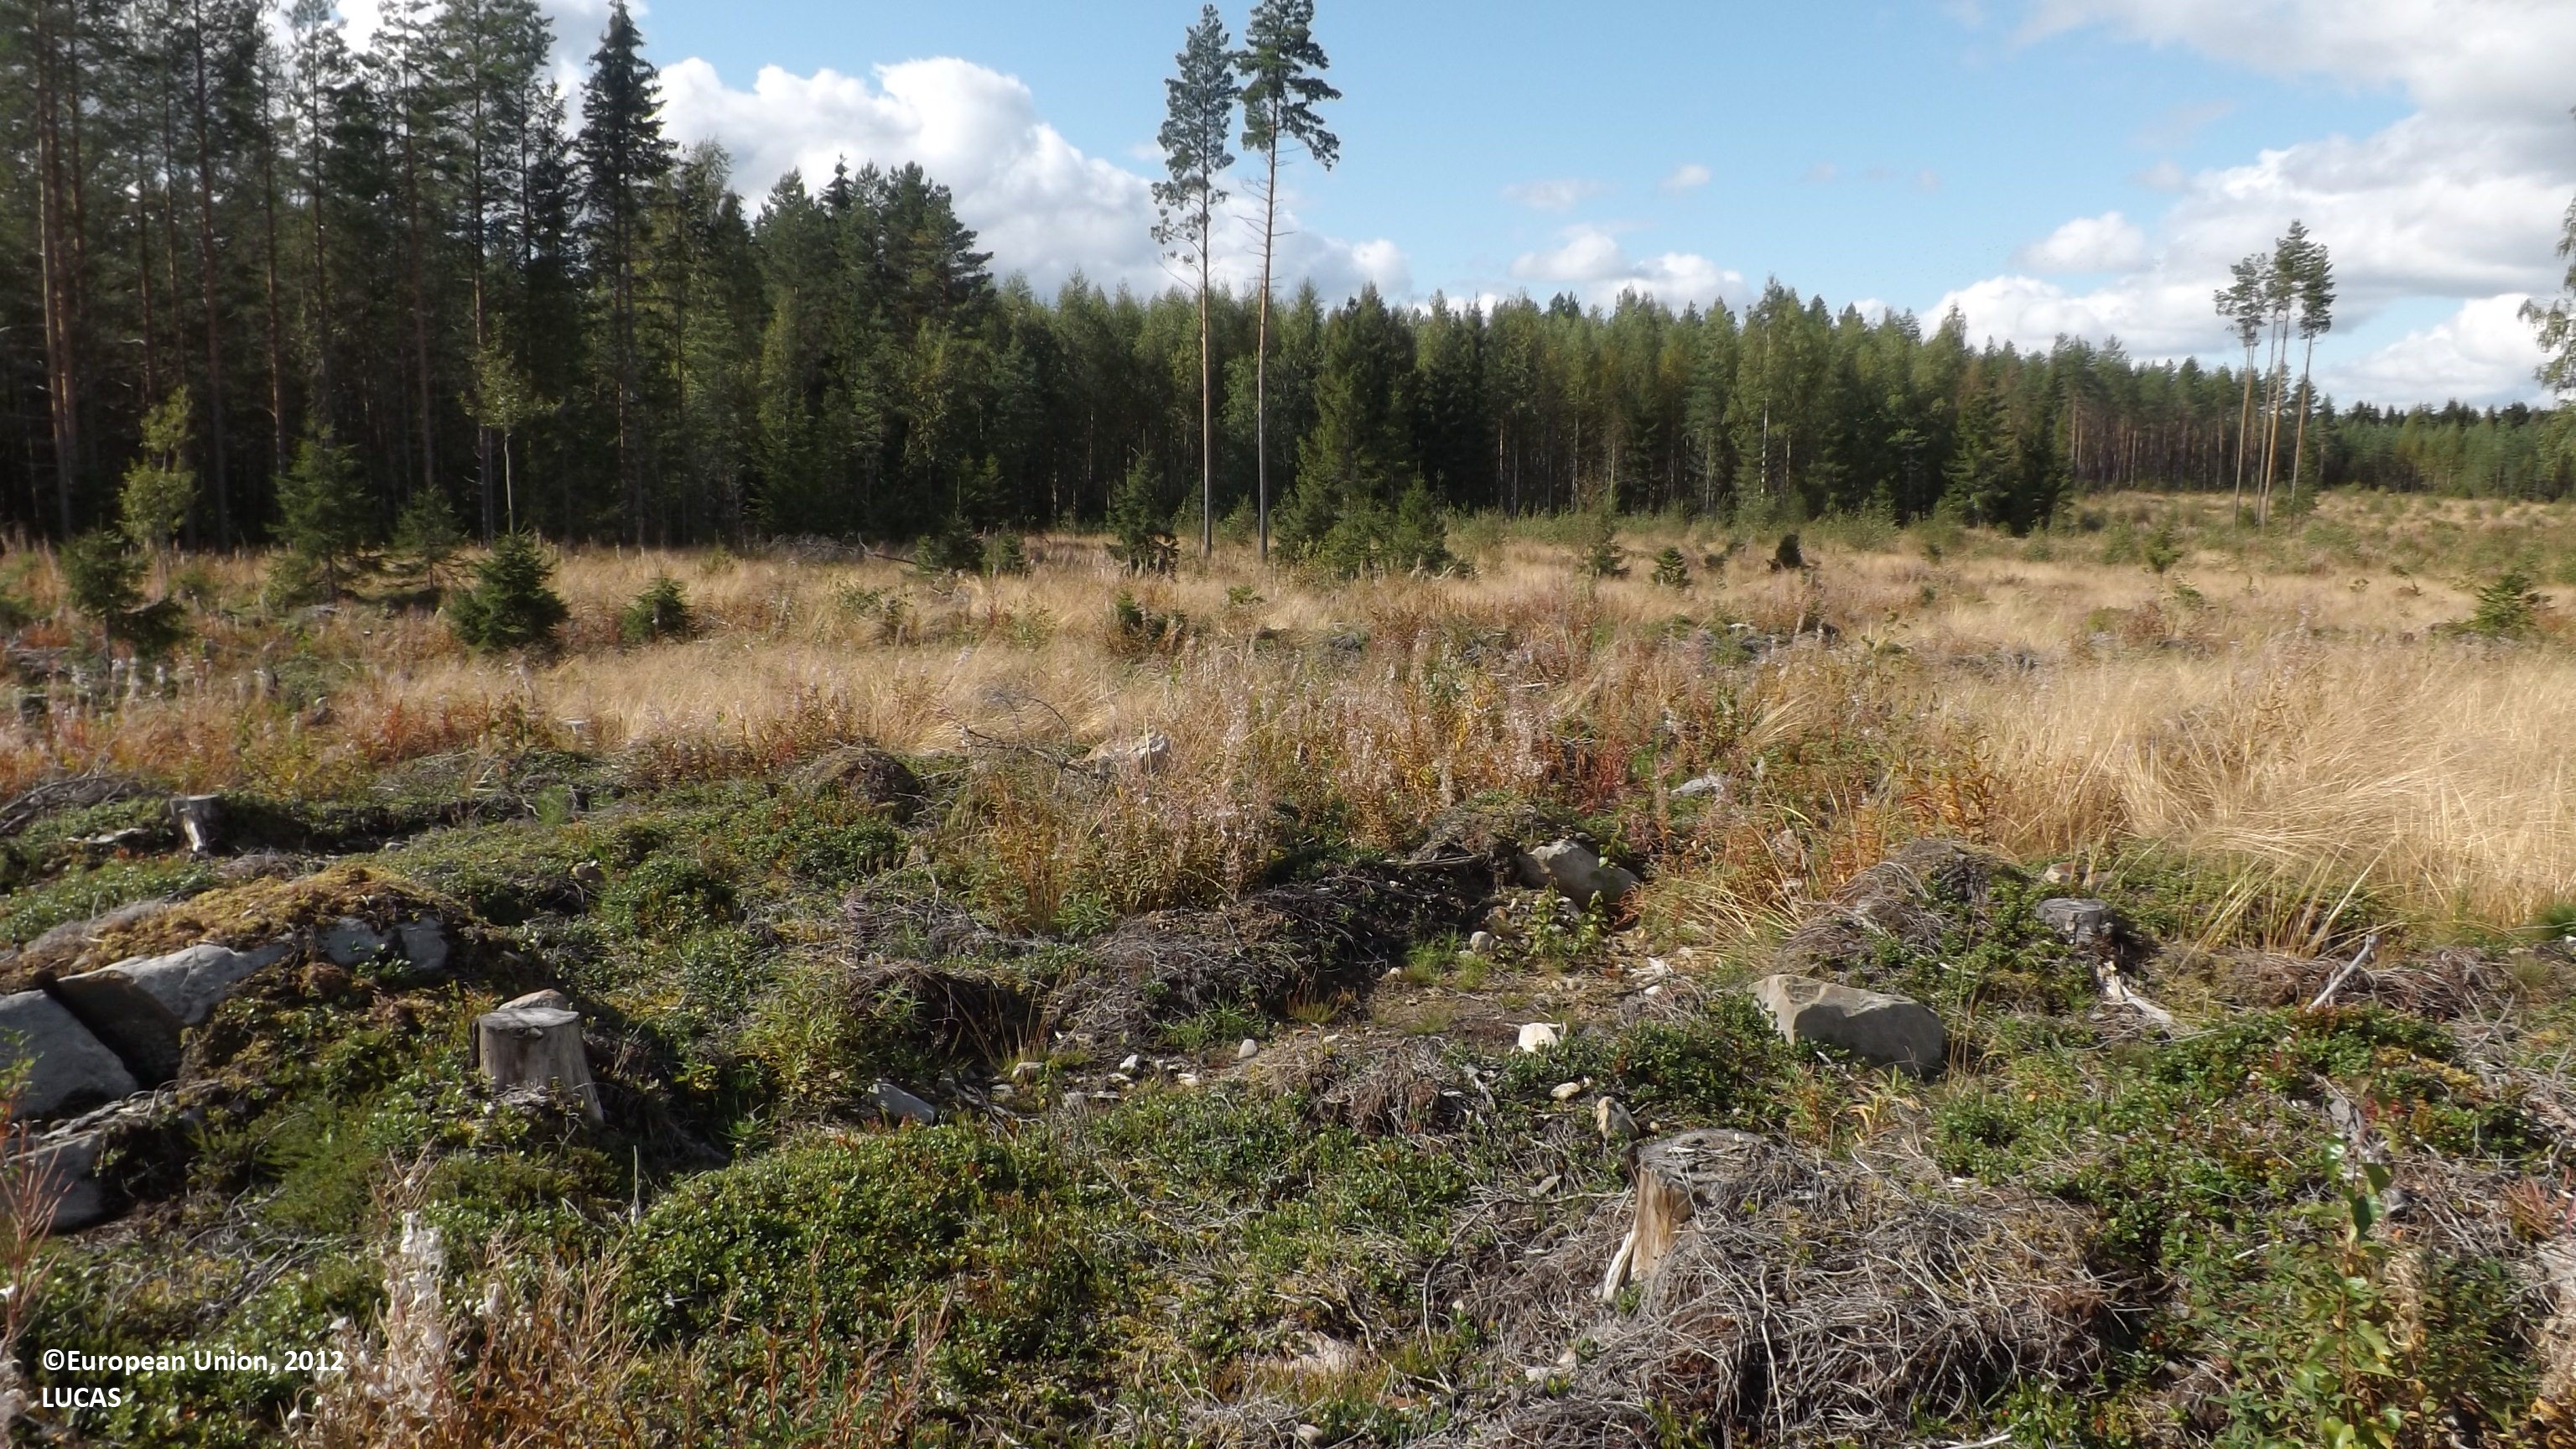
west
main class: Shrubland
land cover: Shrubland without tree cover
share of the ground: 25 - 50 %
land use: Forestry
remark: Clear cut
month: August
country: FI
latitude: 63.6466
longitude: 23.5696
